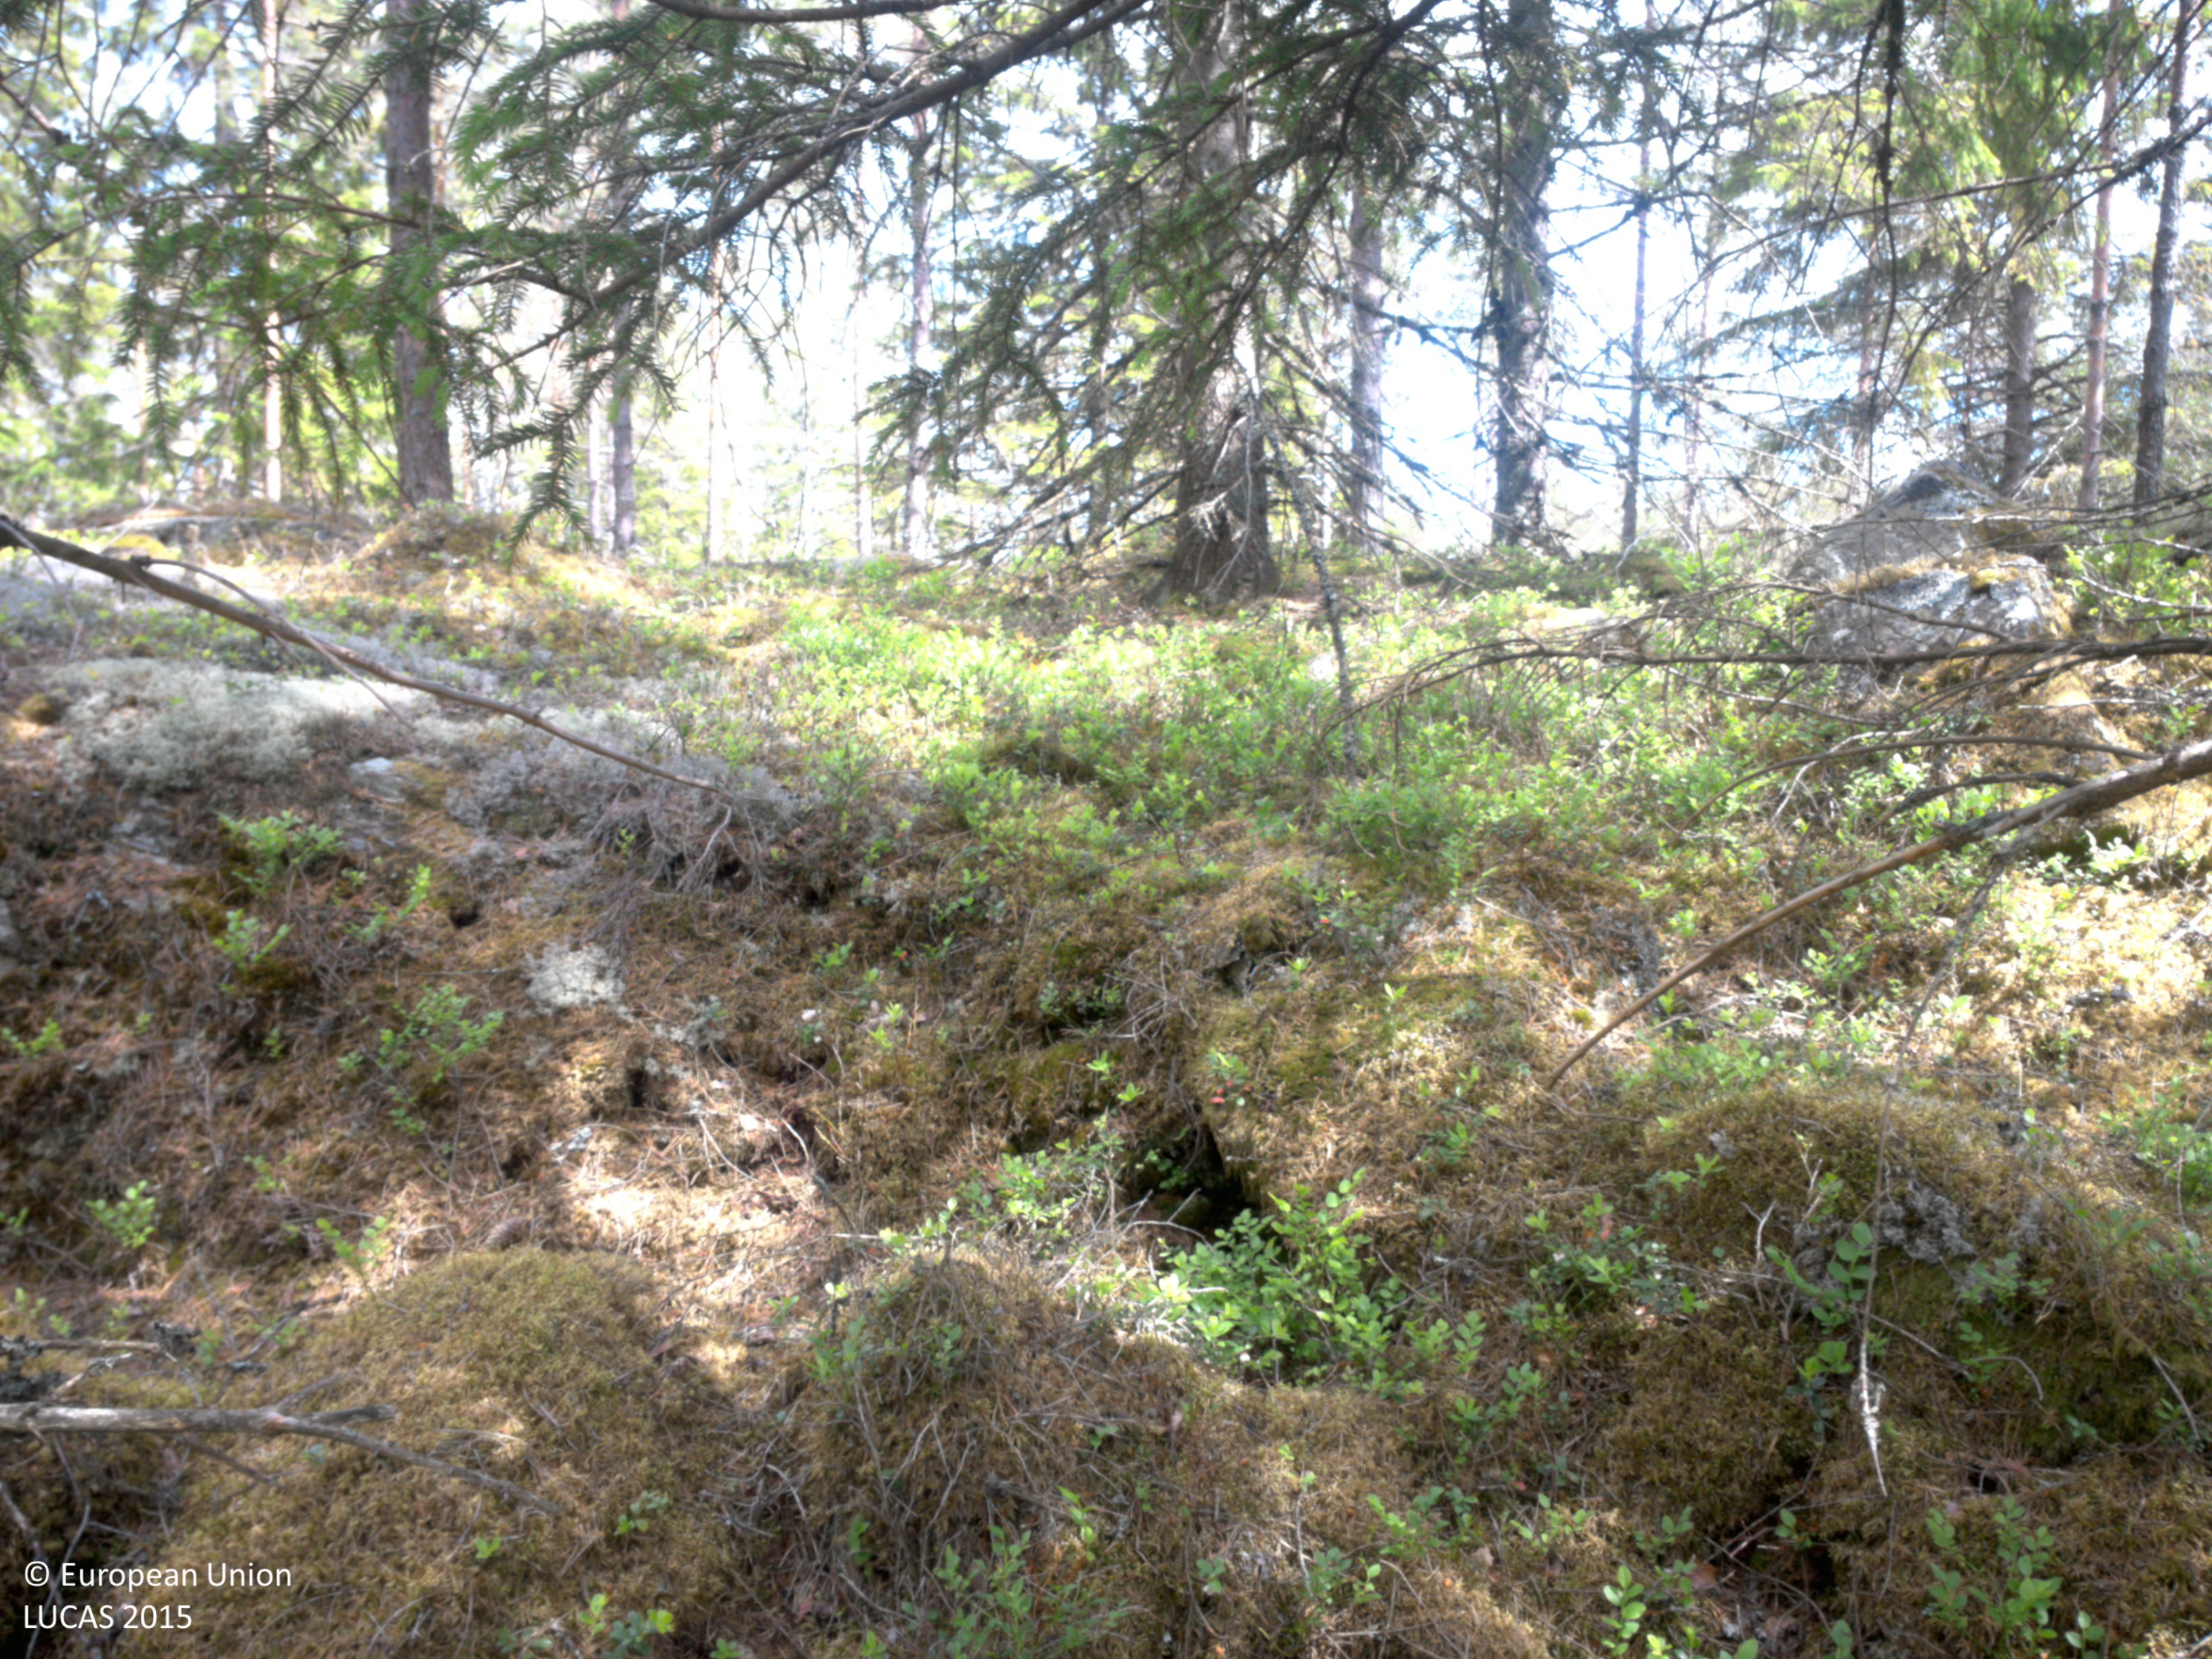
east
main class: Woodland
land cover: Spruce dominated coniferous woodland
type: boreal forest
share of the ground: 25 - 50 %
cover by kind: lichens and mosses 55 %, coniferous forest trees 30 %, shrubs 15 %
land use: Forestry
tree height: > 5 m
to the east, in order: Spruce dominated coniferous woodland; Tracks; Pine dominated coniferous woodland; Rivers and streams; Pine dominated coniferous woodland; Rivers and streams; Rock outcrops; Spruce dominated coniferous woodland
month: June
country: SE
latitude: 58.8391
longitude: 11.6422
